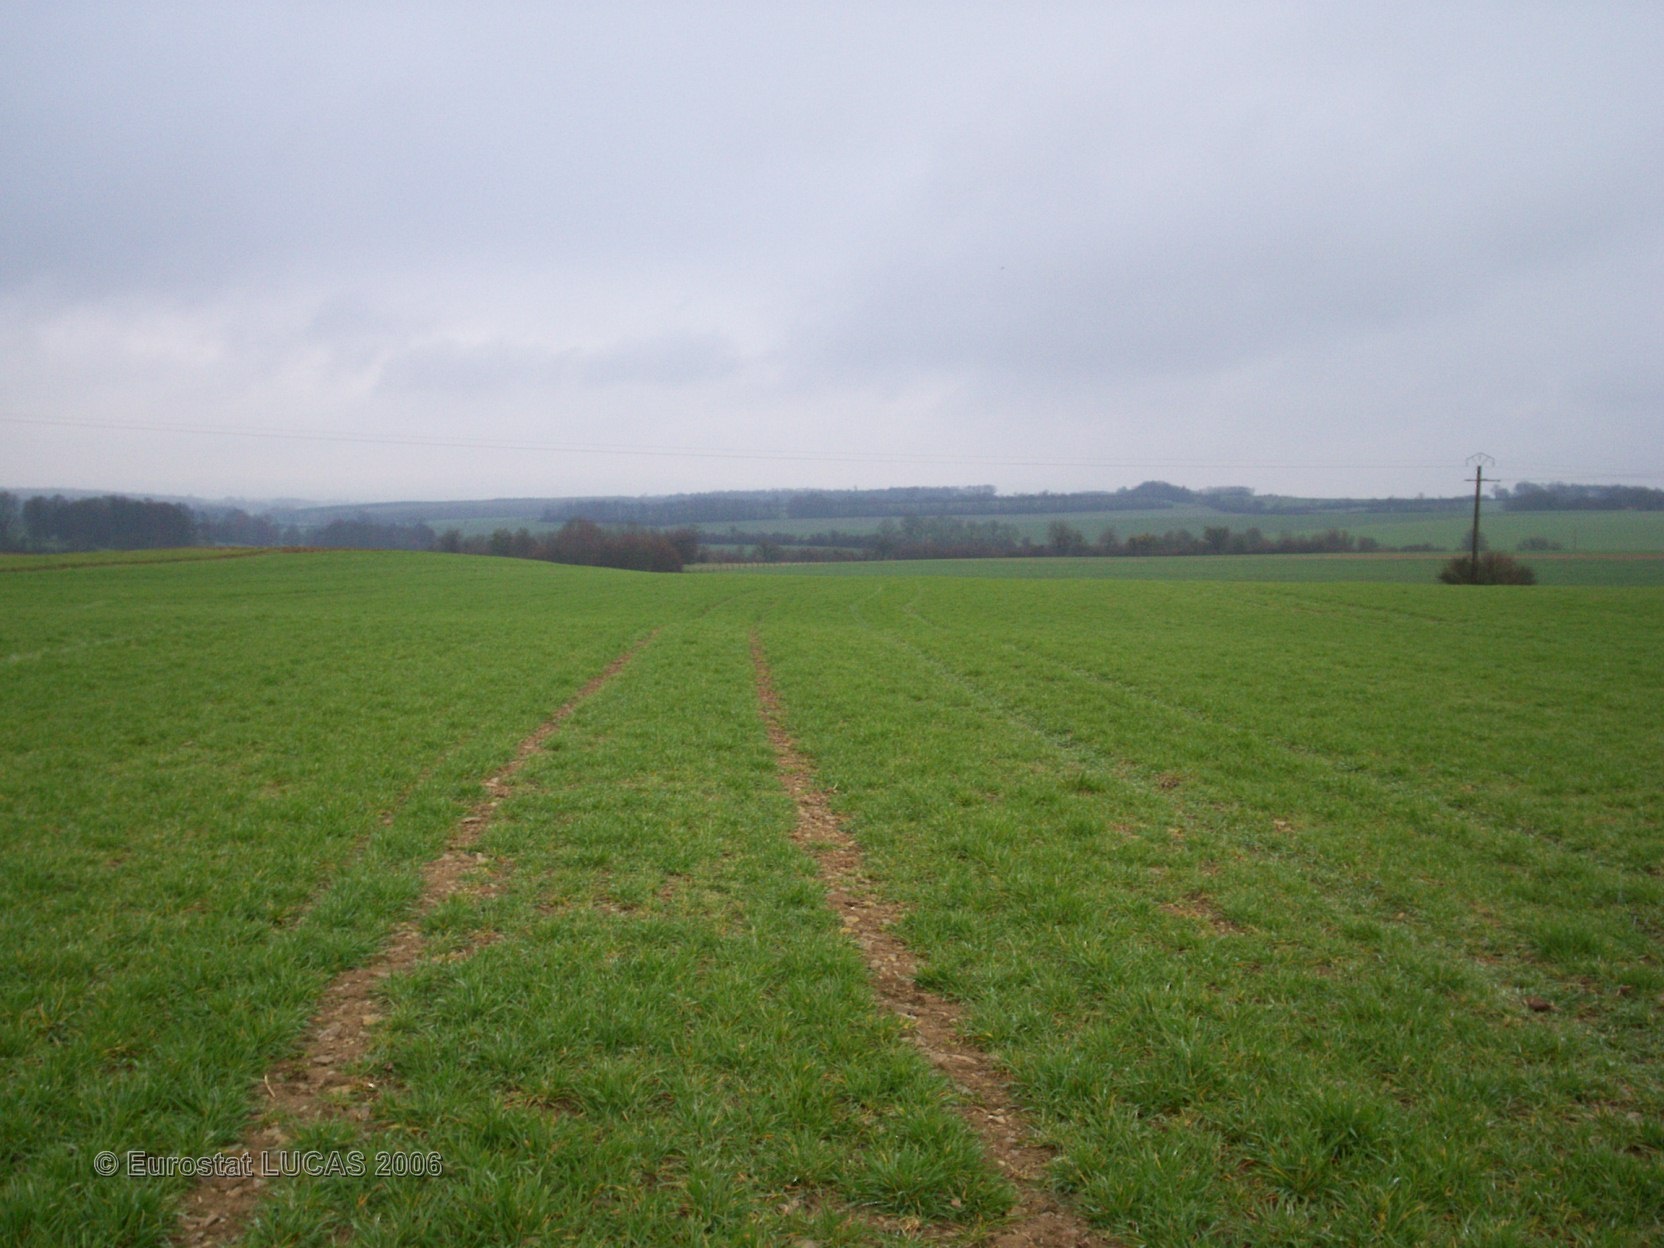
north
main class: Cropland
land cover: Barley
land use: Agriculture (excluding fallow land and kitchen gardens)
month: April
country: FR
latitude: 48.1598
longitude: 6.2497
